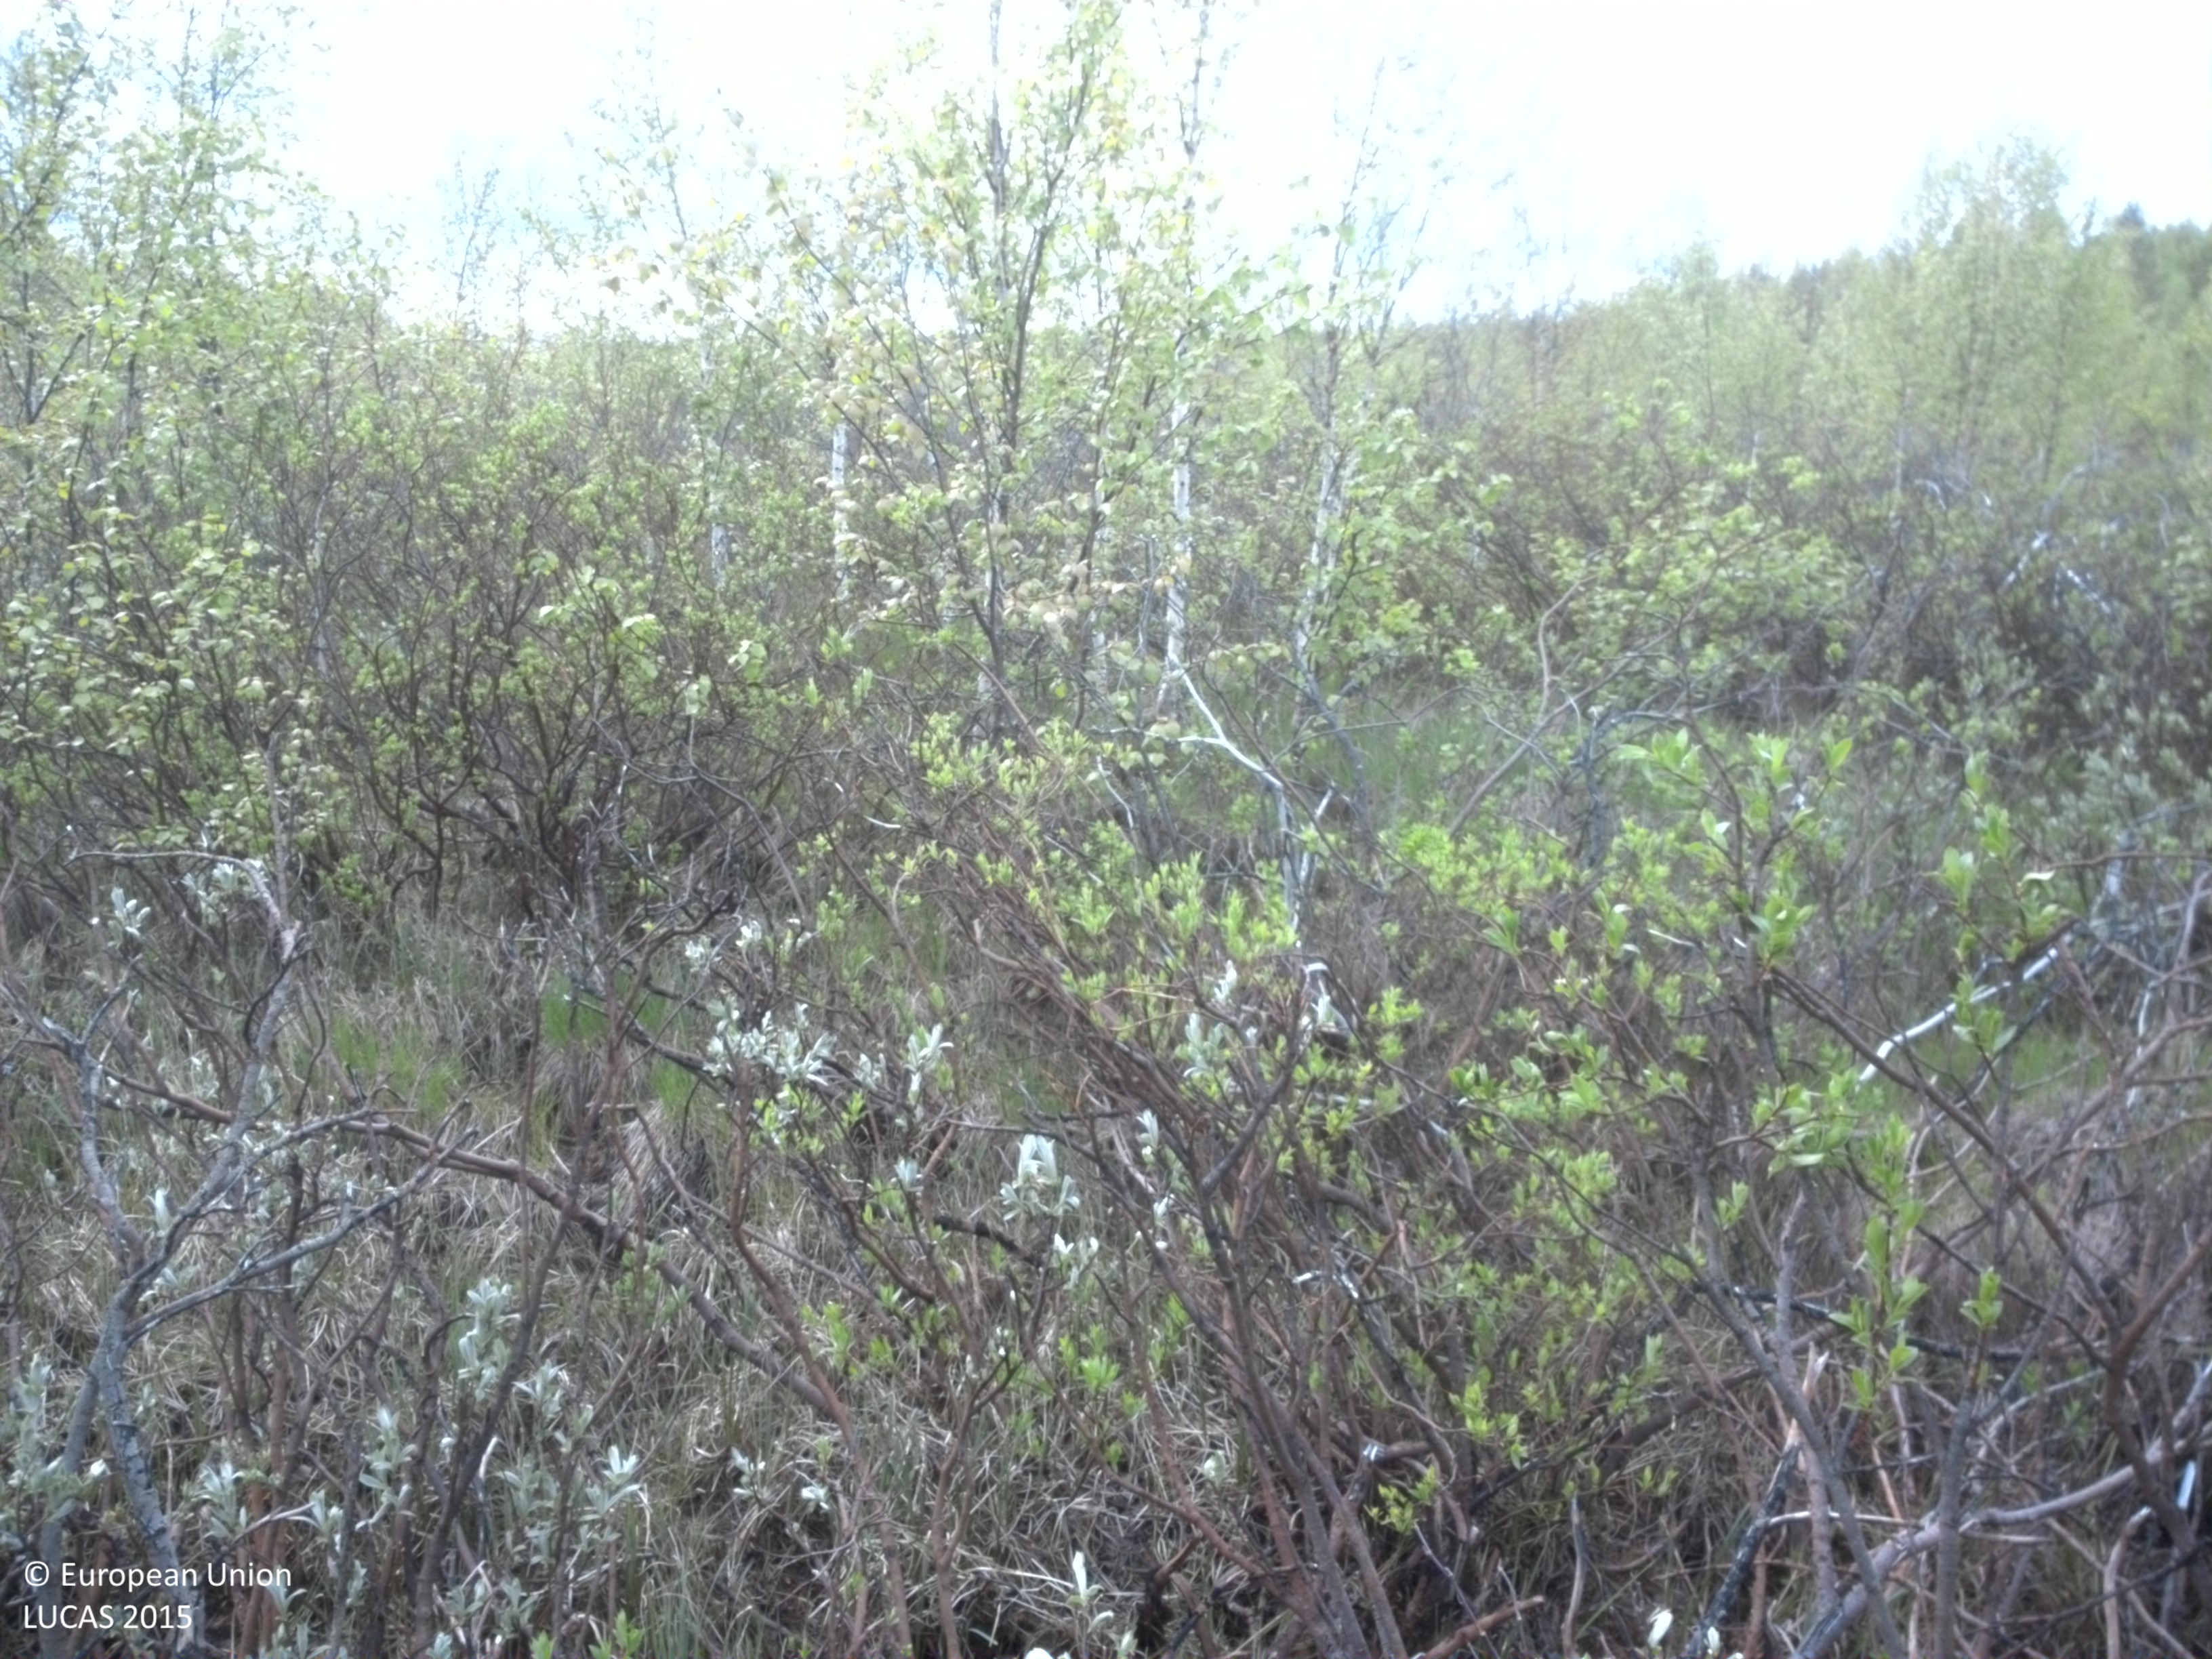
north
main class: Woodland
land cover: Broadleaved woodland
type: boreal forest
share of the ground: 25 - 50 %
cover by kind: shrubs 55 %, broadleaved forest trees 40 %, herbaceous plants 5 %
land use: Semi-natural and natural areas not in use
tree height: > 5 m
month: June
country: SE
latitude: 67.0127
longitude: 21.8681
